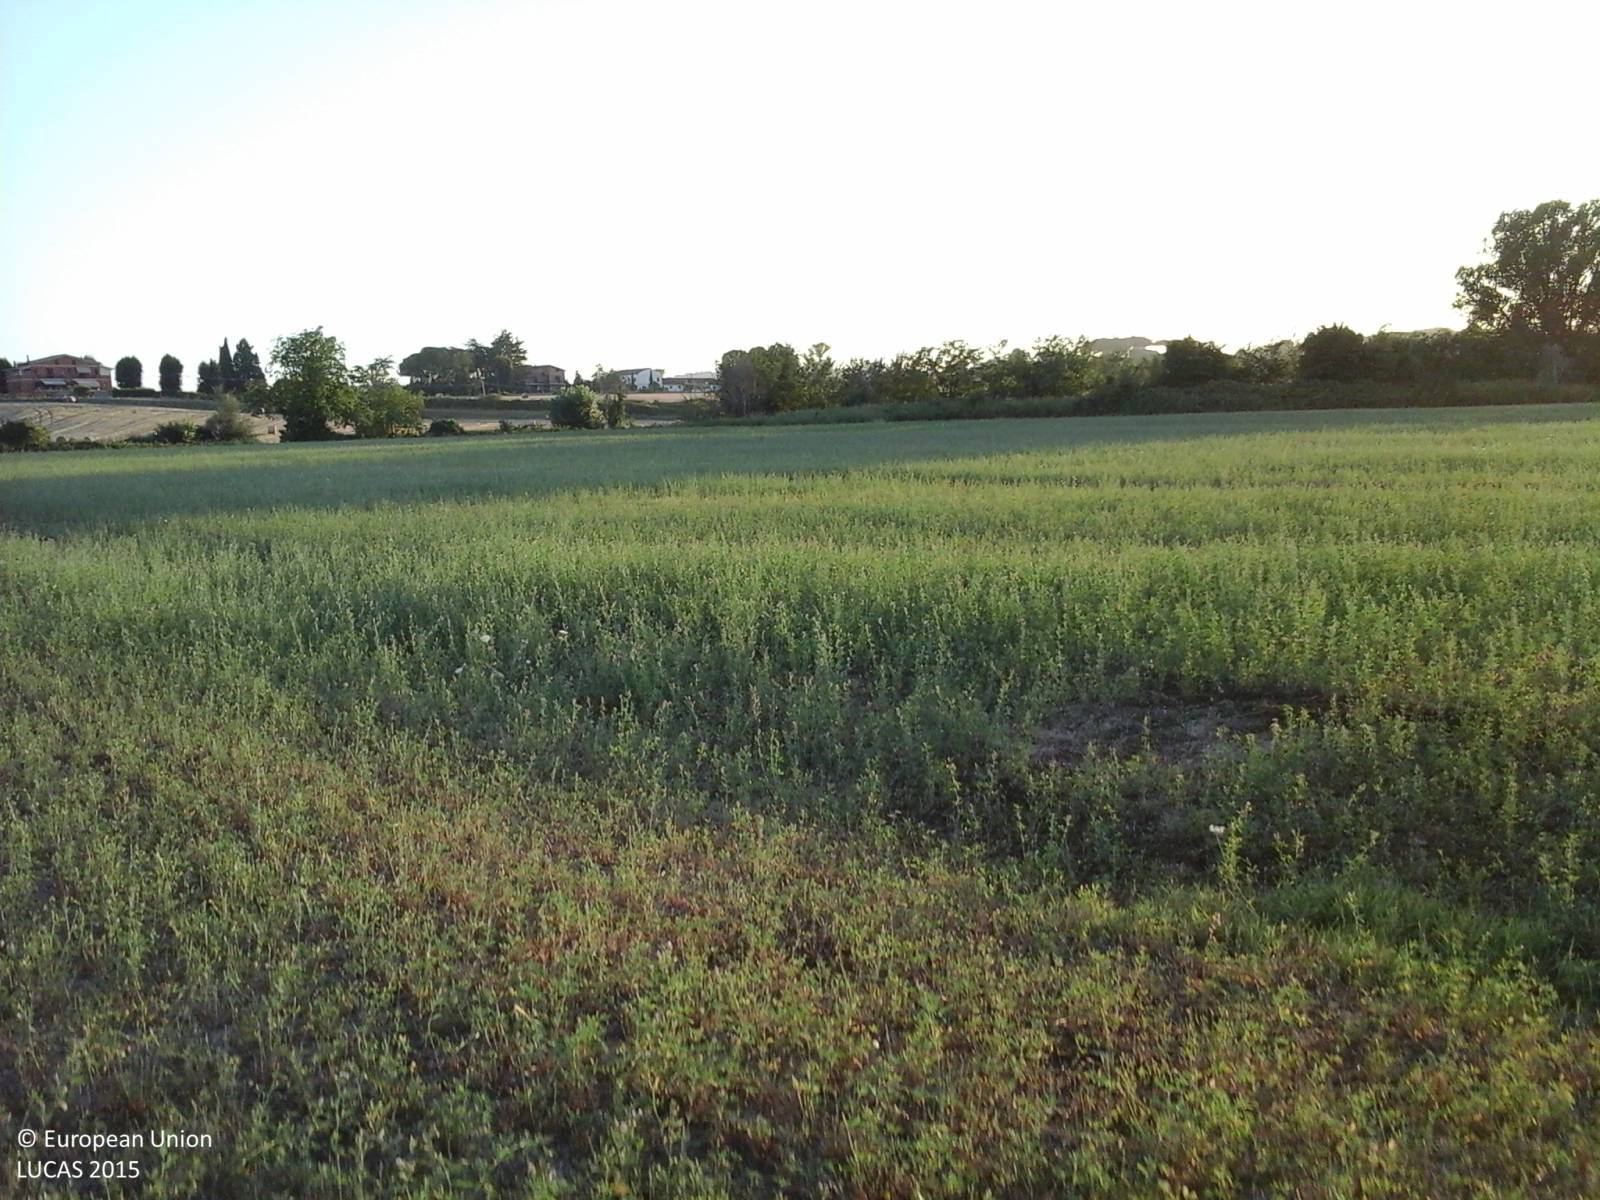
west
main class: Cropland
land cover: Lucerne
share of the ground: > 75 %
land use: Agriculture (excluding fallow land and kitchen gardens)
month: July
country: IT
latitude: 42.1335
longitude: 12.5678
